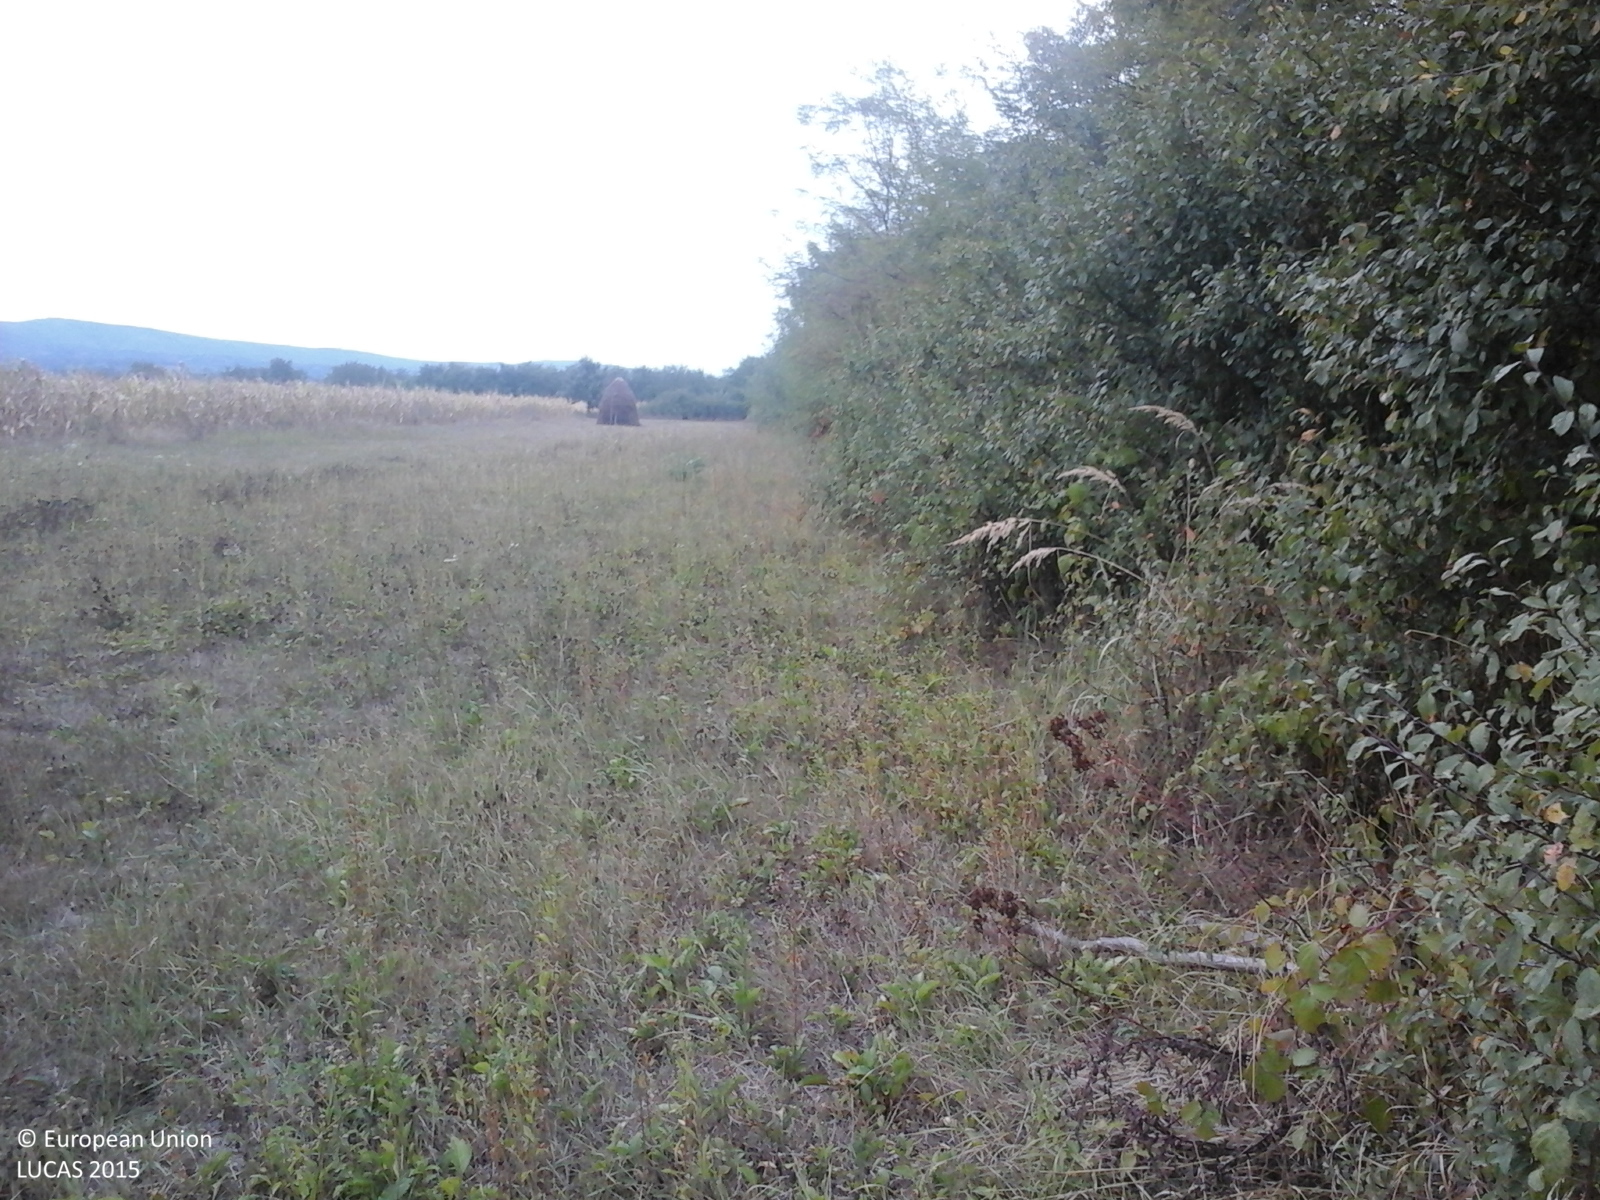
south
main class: Shrubland
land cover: Shrubland with sparse tree cover
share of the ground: > 75 %
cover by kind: shrubs 95 %, broadleaved forest trees 5 %
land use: Semi-natural and natural areas not in use
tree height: > 5 m
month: September
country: RO
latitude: 47.6915
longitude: 23.1118
